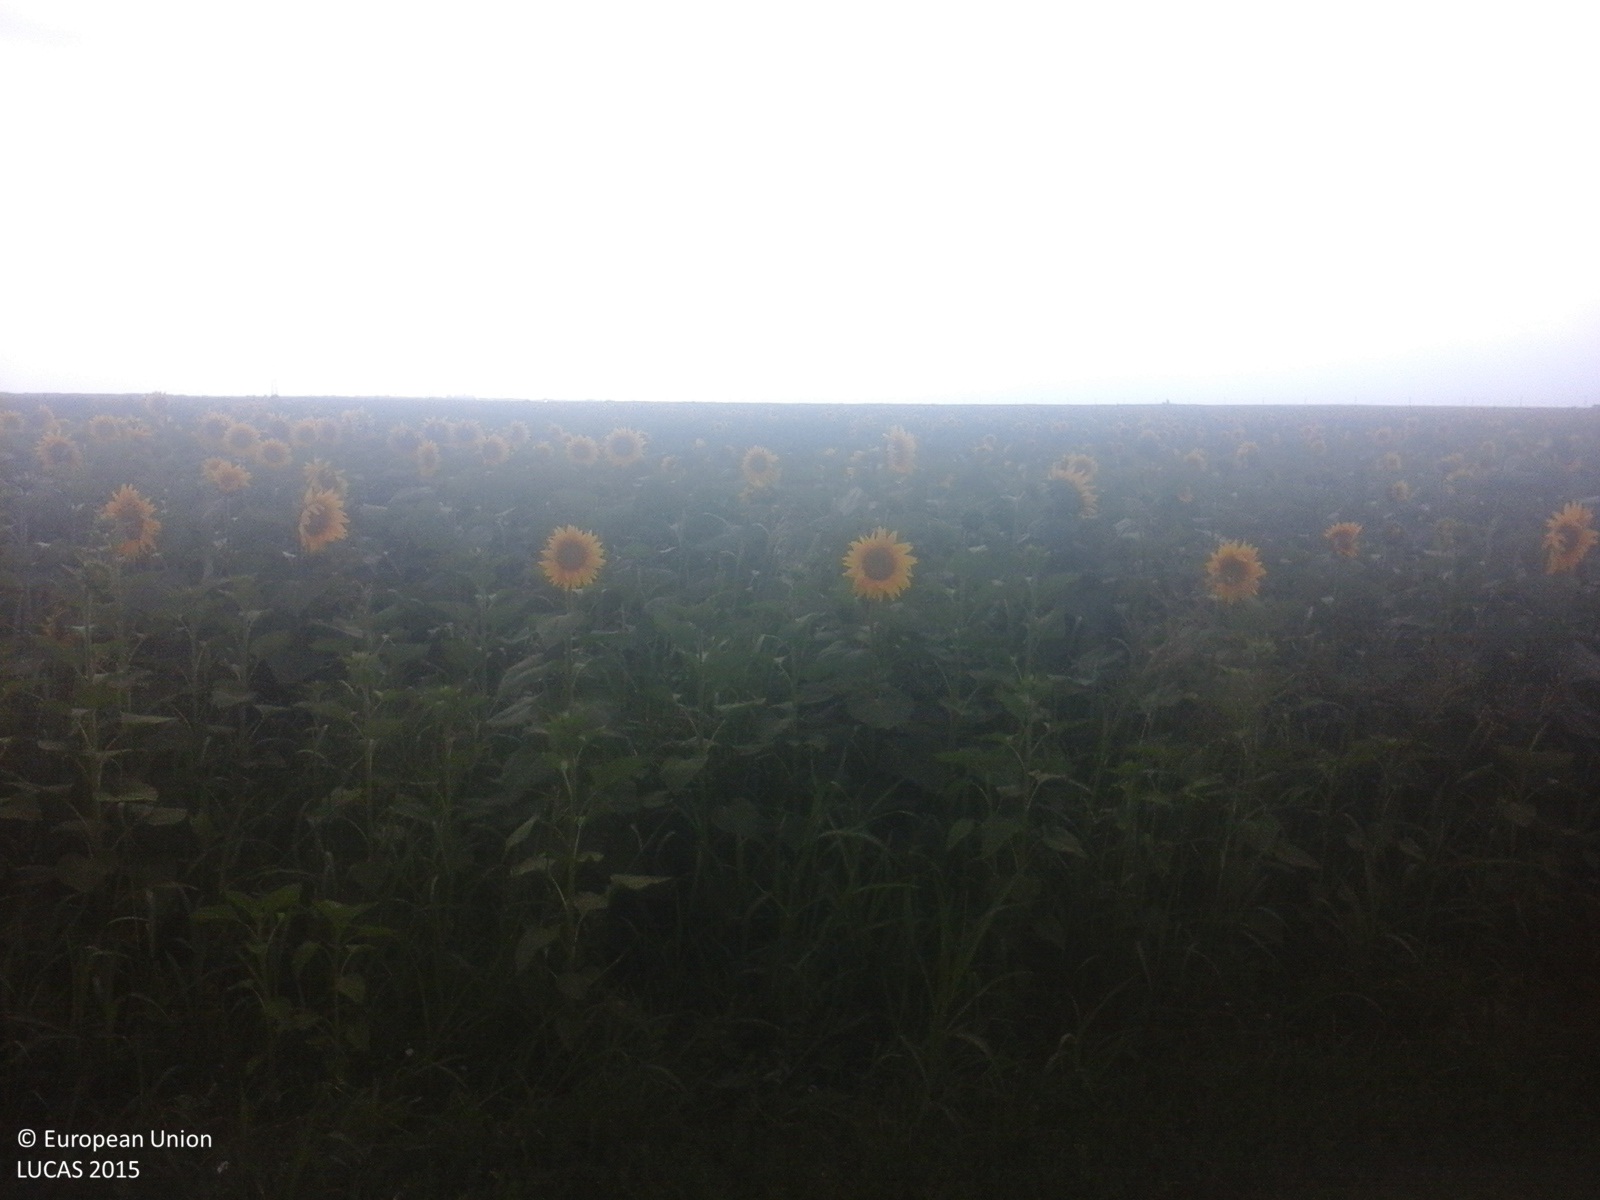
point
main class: Cropland
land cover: Sunflower
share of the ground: > 75 %
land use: Agriculture (excluding fallow land and kitchen gardens)
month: July
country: RO
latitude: 43.7848
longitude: 24.6176
